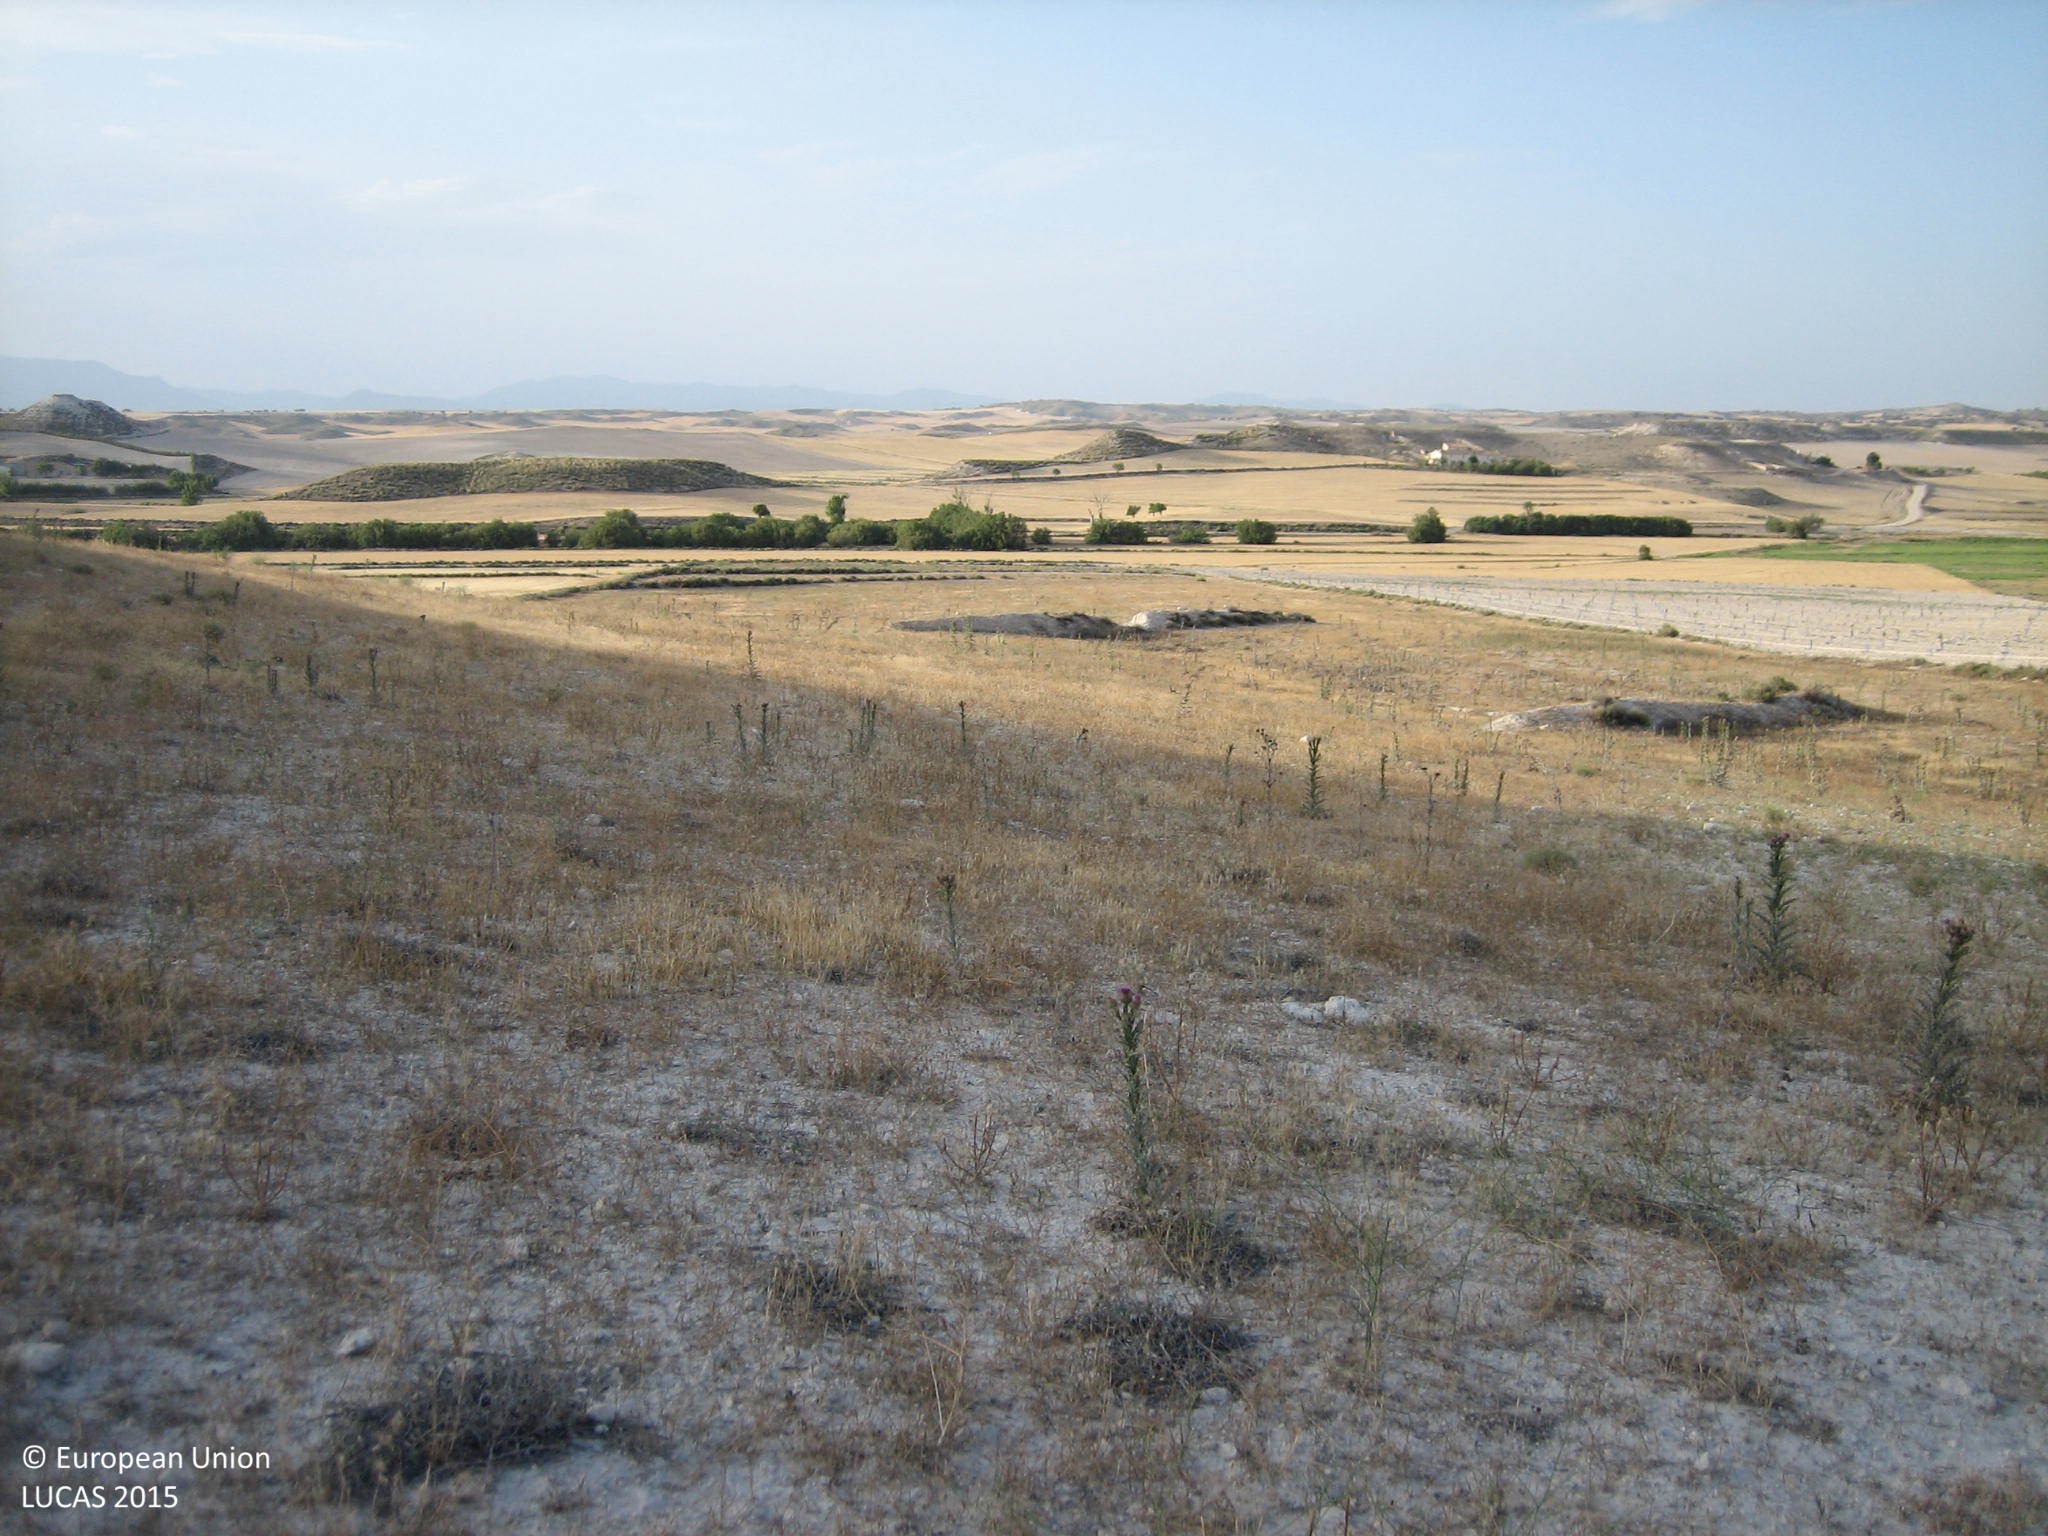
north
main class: Grassland
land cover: Spontaneously vegetated surfaces
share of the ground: 25 - 50 %
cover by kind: unconsolidated bare surface 70 %, herbaceous plants 30 %
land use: Fallow land
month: July
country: ES
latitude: 37.7370
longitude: -2.4135
